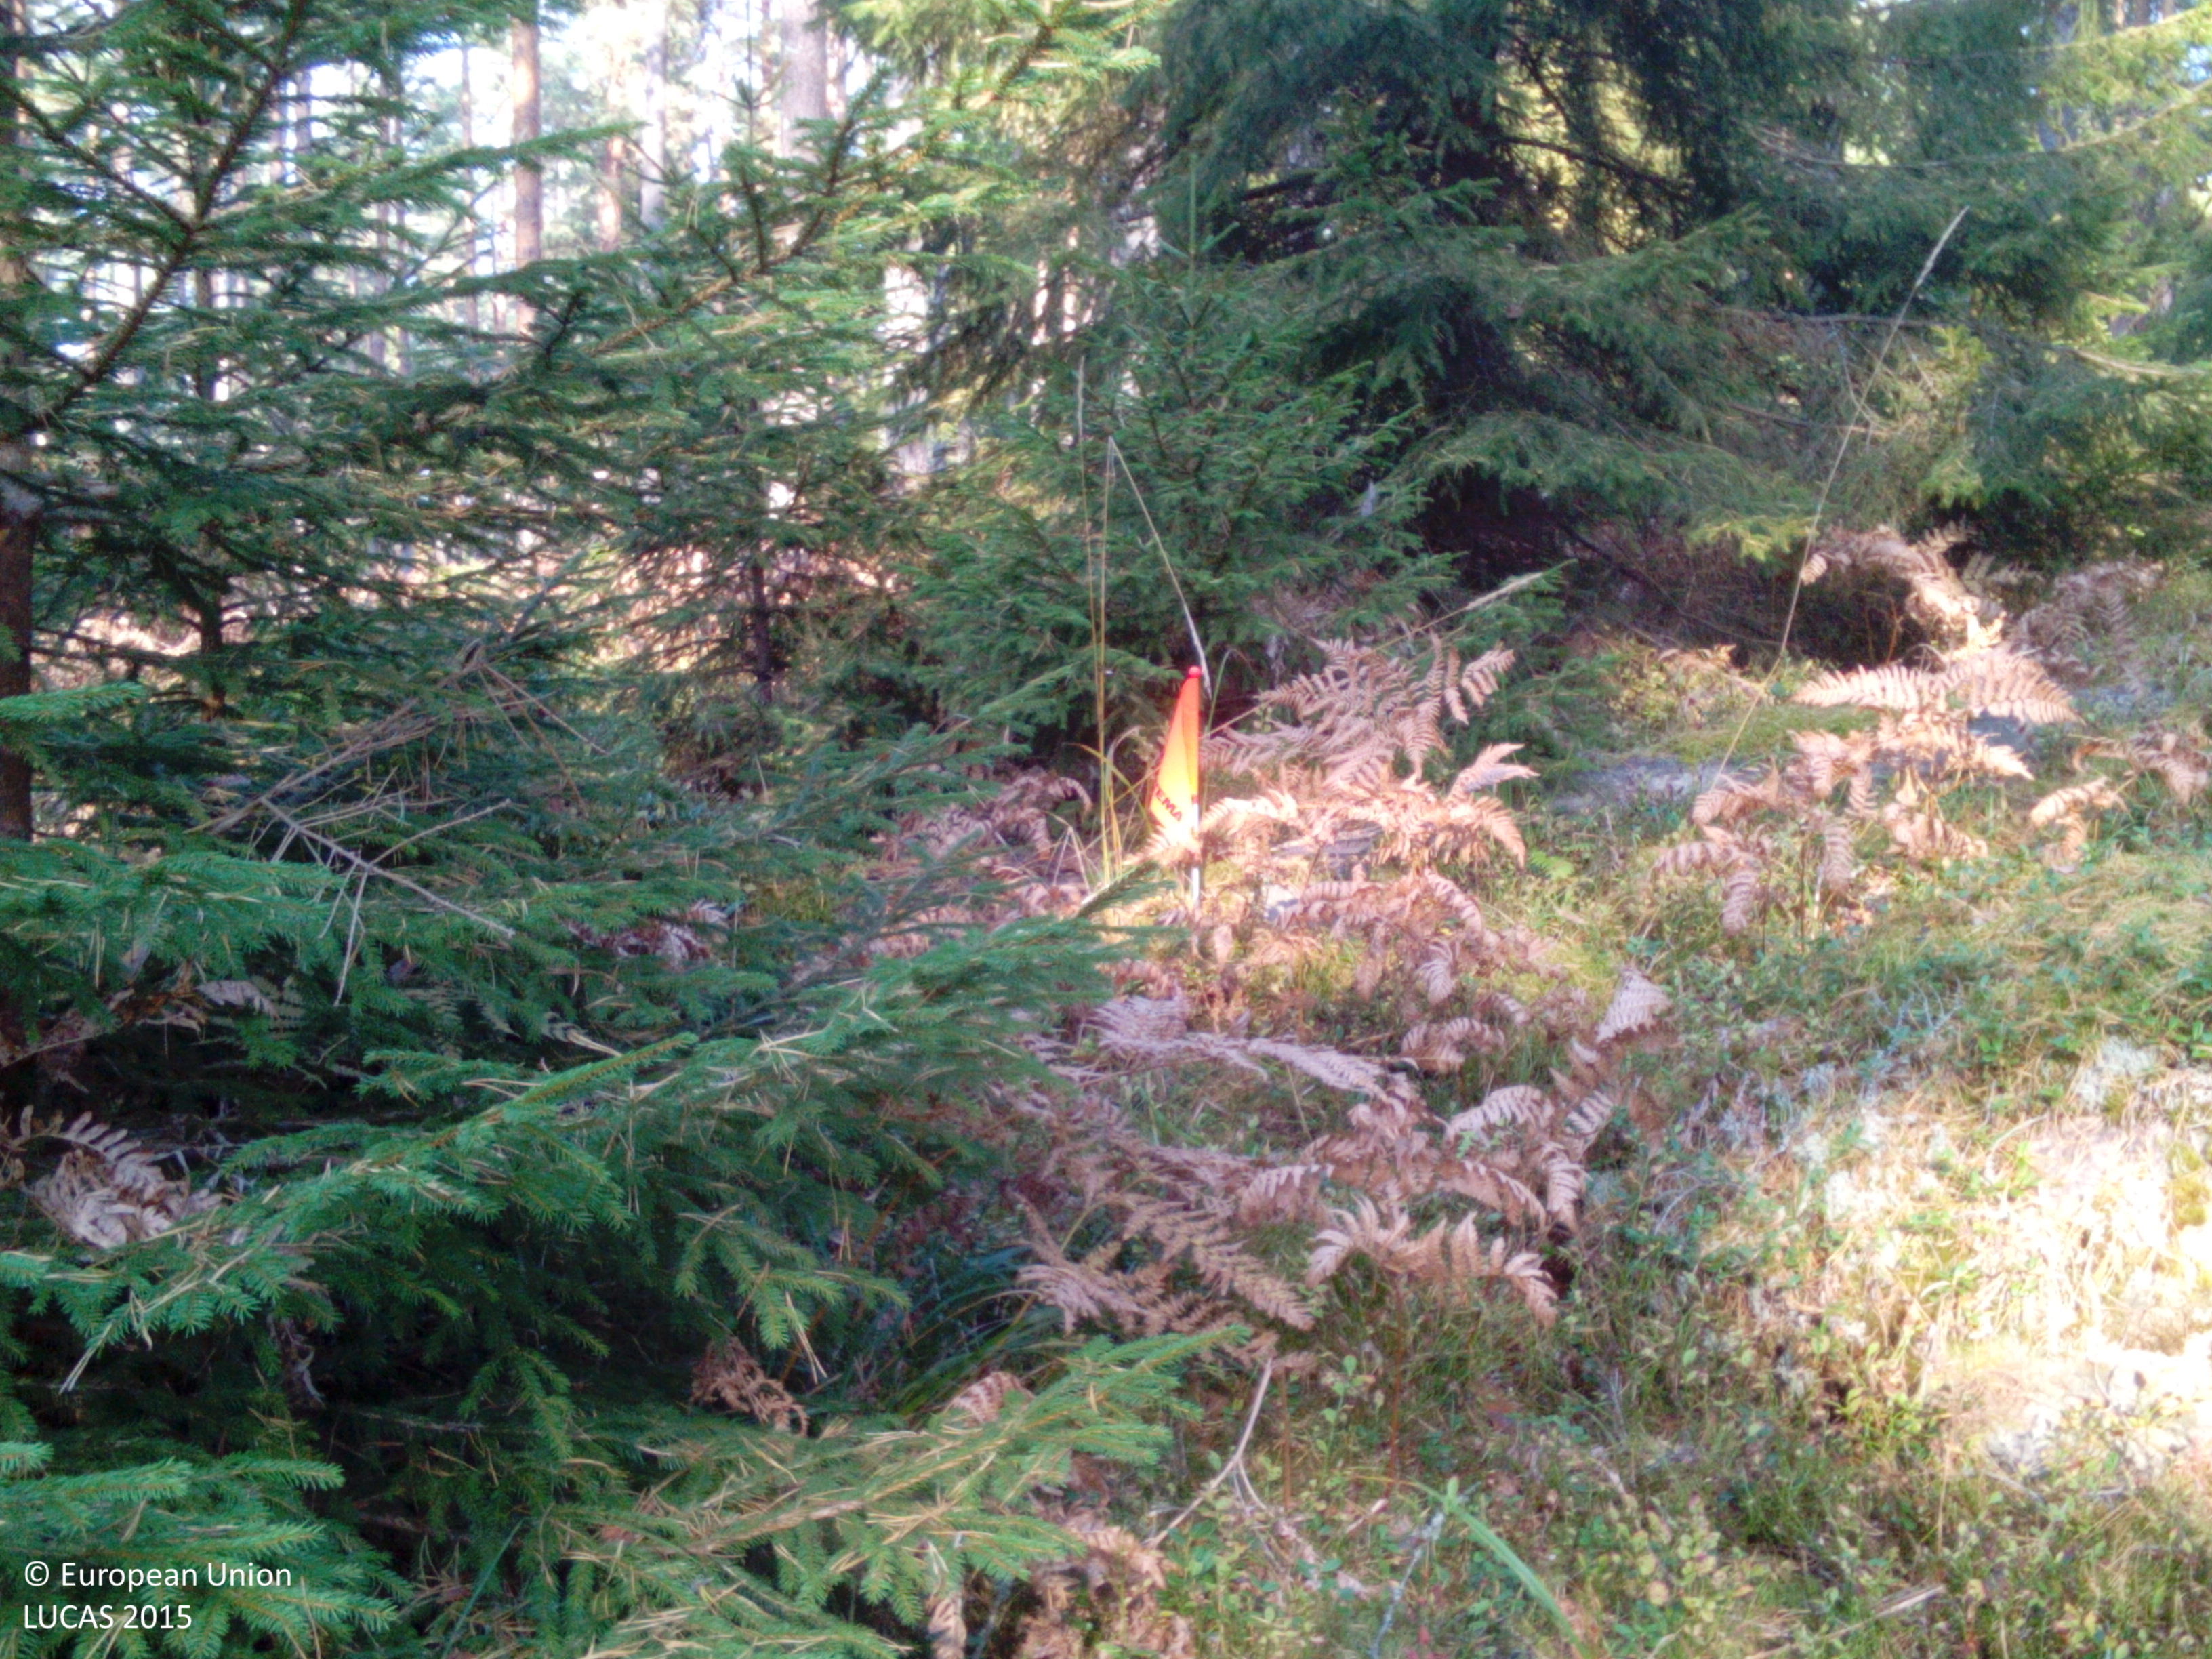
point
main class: Woodland
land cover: Other coniferous woodland
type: boreal forest
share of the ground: > 75 %
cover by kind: coniferous forest trees 85 %, herbaceous plants 10 %, lichens and mosses 5 %
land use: Forestry
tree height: > 5 m
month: October
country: SE
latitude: 58.8877
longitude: 16.2231
